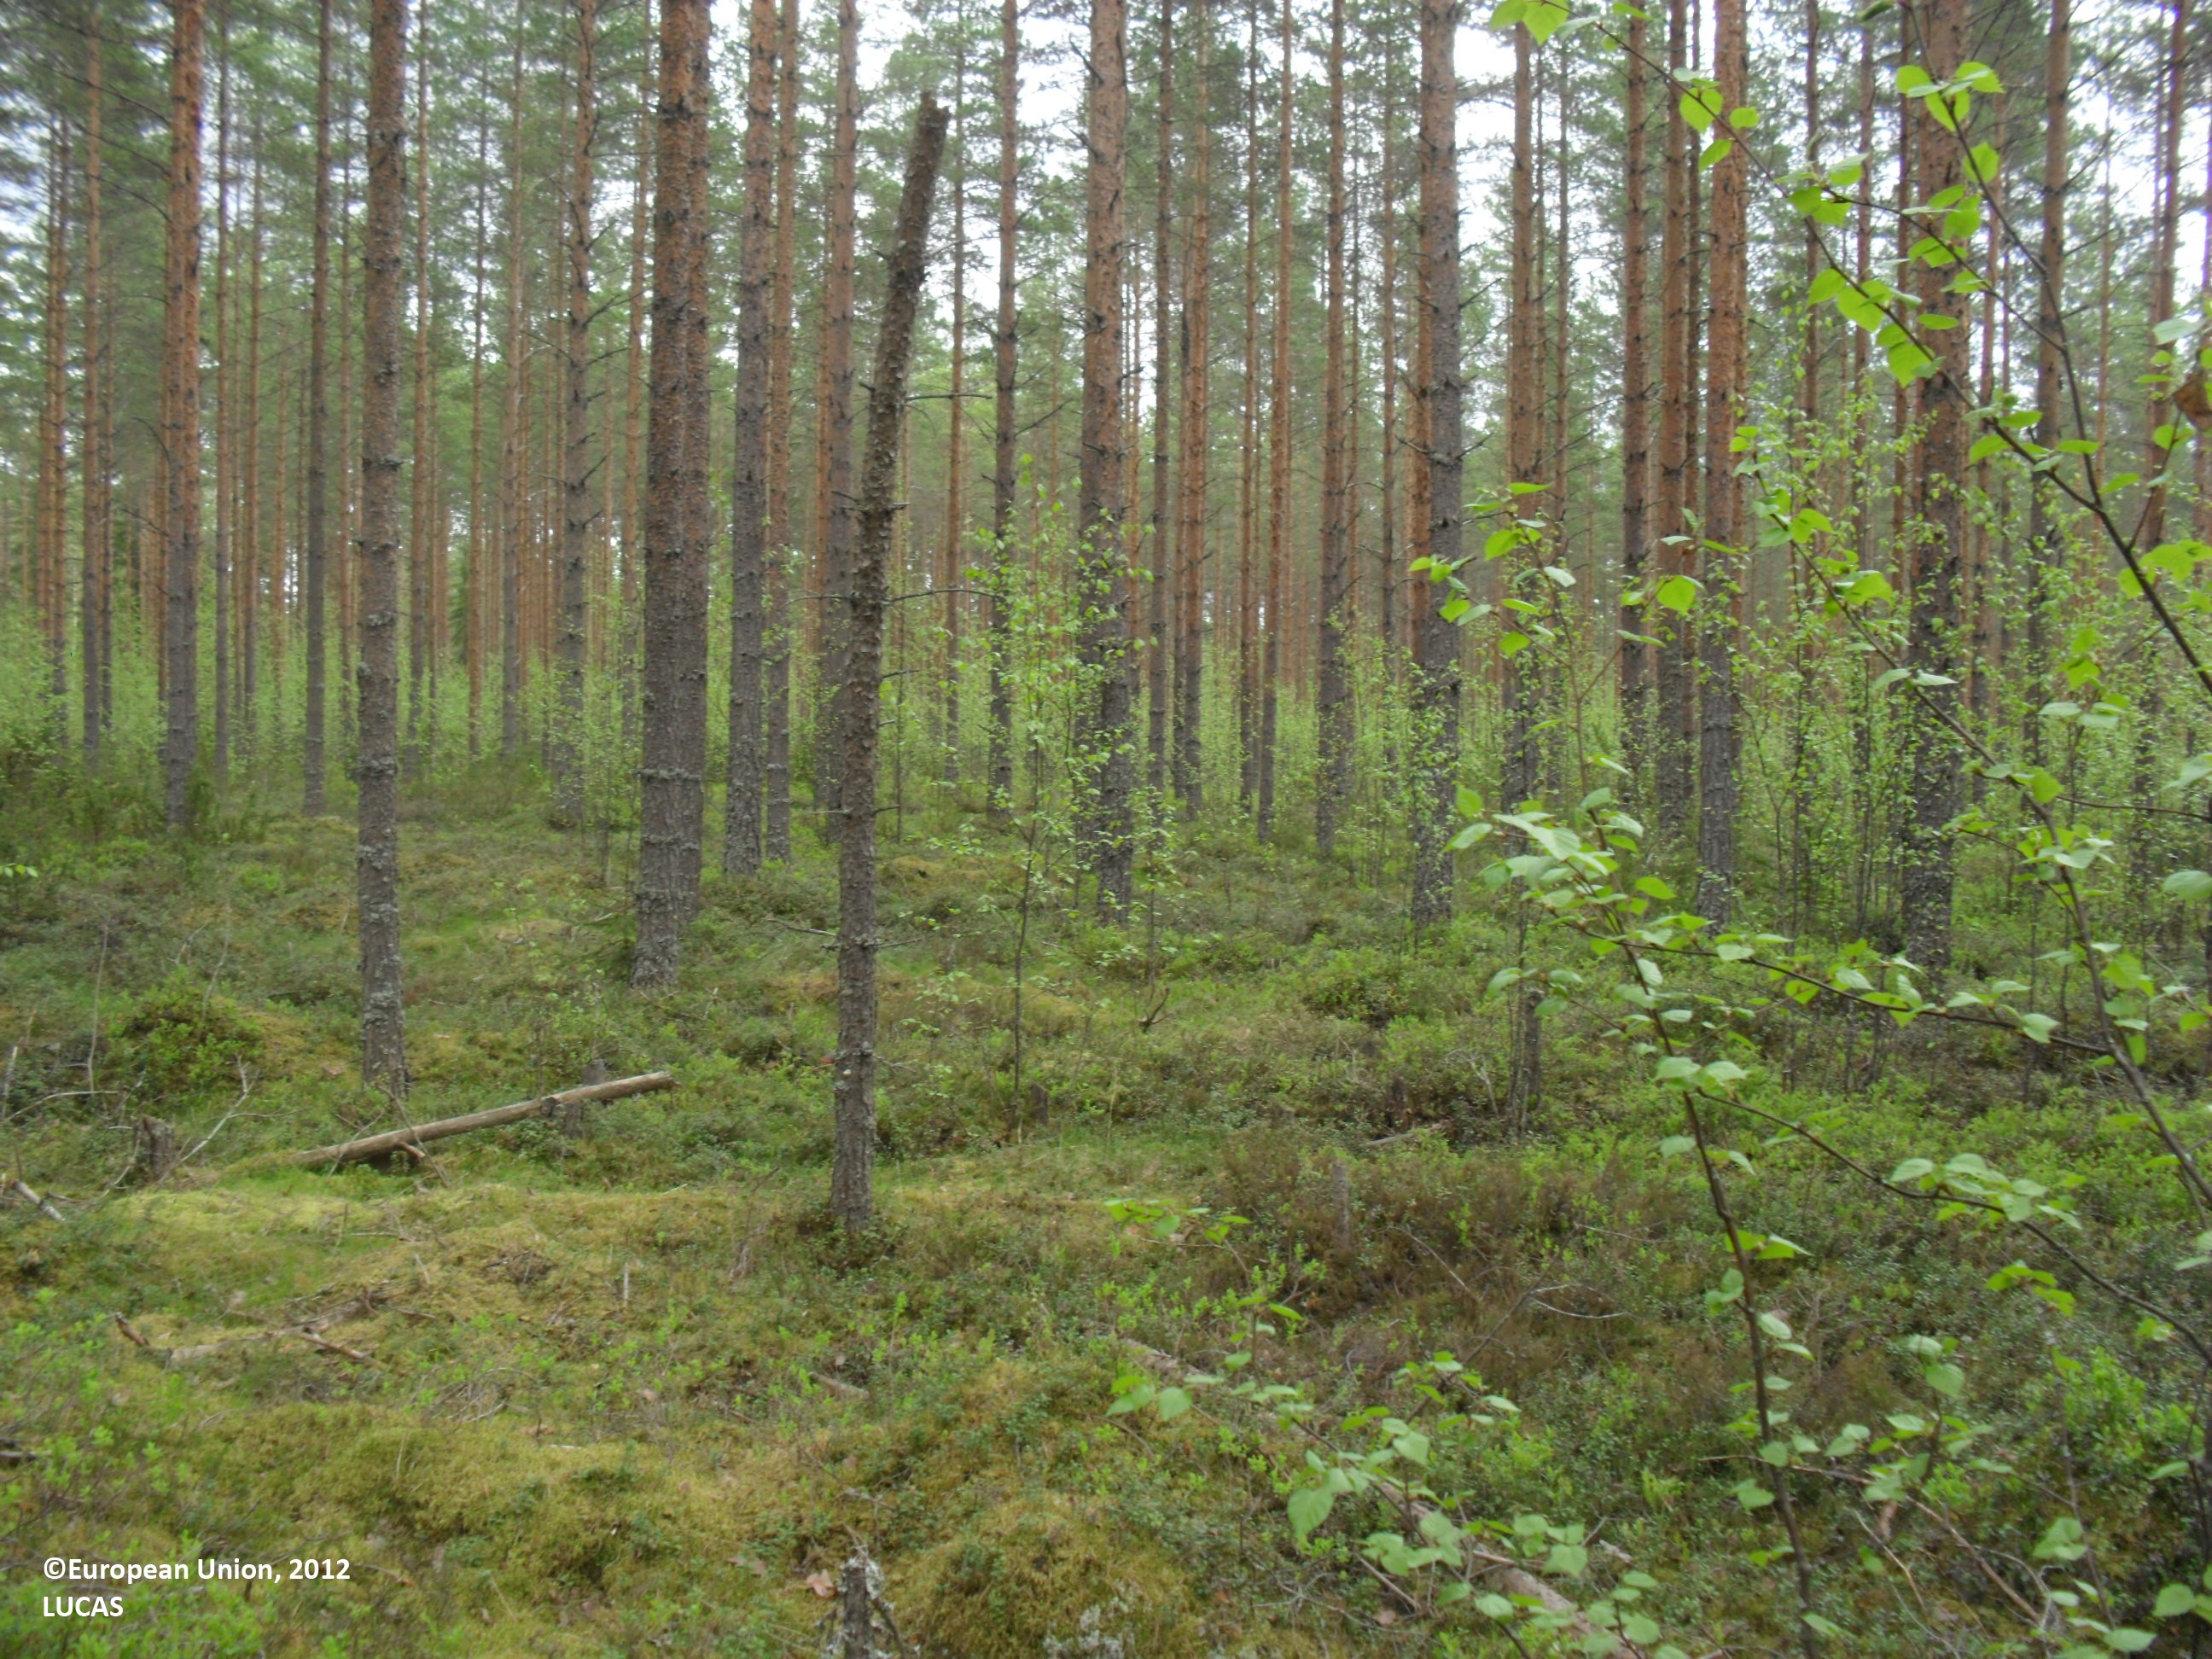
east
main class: Woodland
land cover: Pine dominated coniferous woodland
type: boreal forest
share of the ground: 50 - 75 %
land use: Forestry
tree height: > 5 m
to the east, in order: Pine dominated coniferous woodland; Ditches and canals; Pine dominated coniferous woodland; Ditches and canals; Pine dominated coniferous woodland; Tracks; Pine dominated coniferous woodland; Tracks; Pine dominated coniferous woodland; Ditches and canals; Other mixed woodland; Pine dominated coniferous woodland; Tracks; Pine dominated coniferous woodland
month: June
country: FI
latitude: 63.0996
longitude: 23.3164
